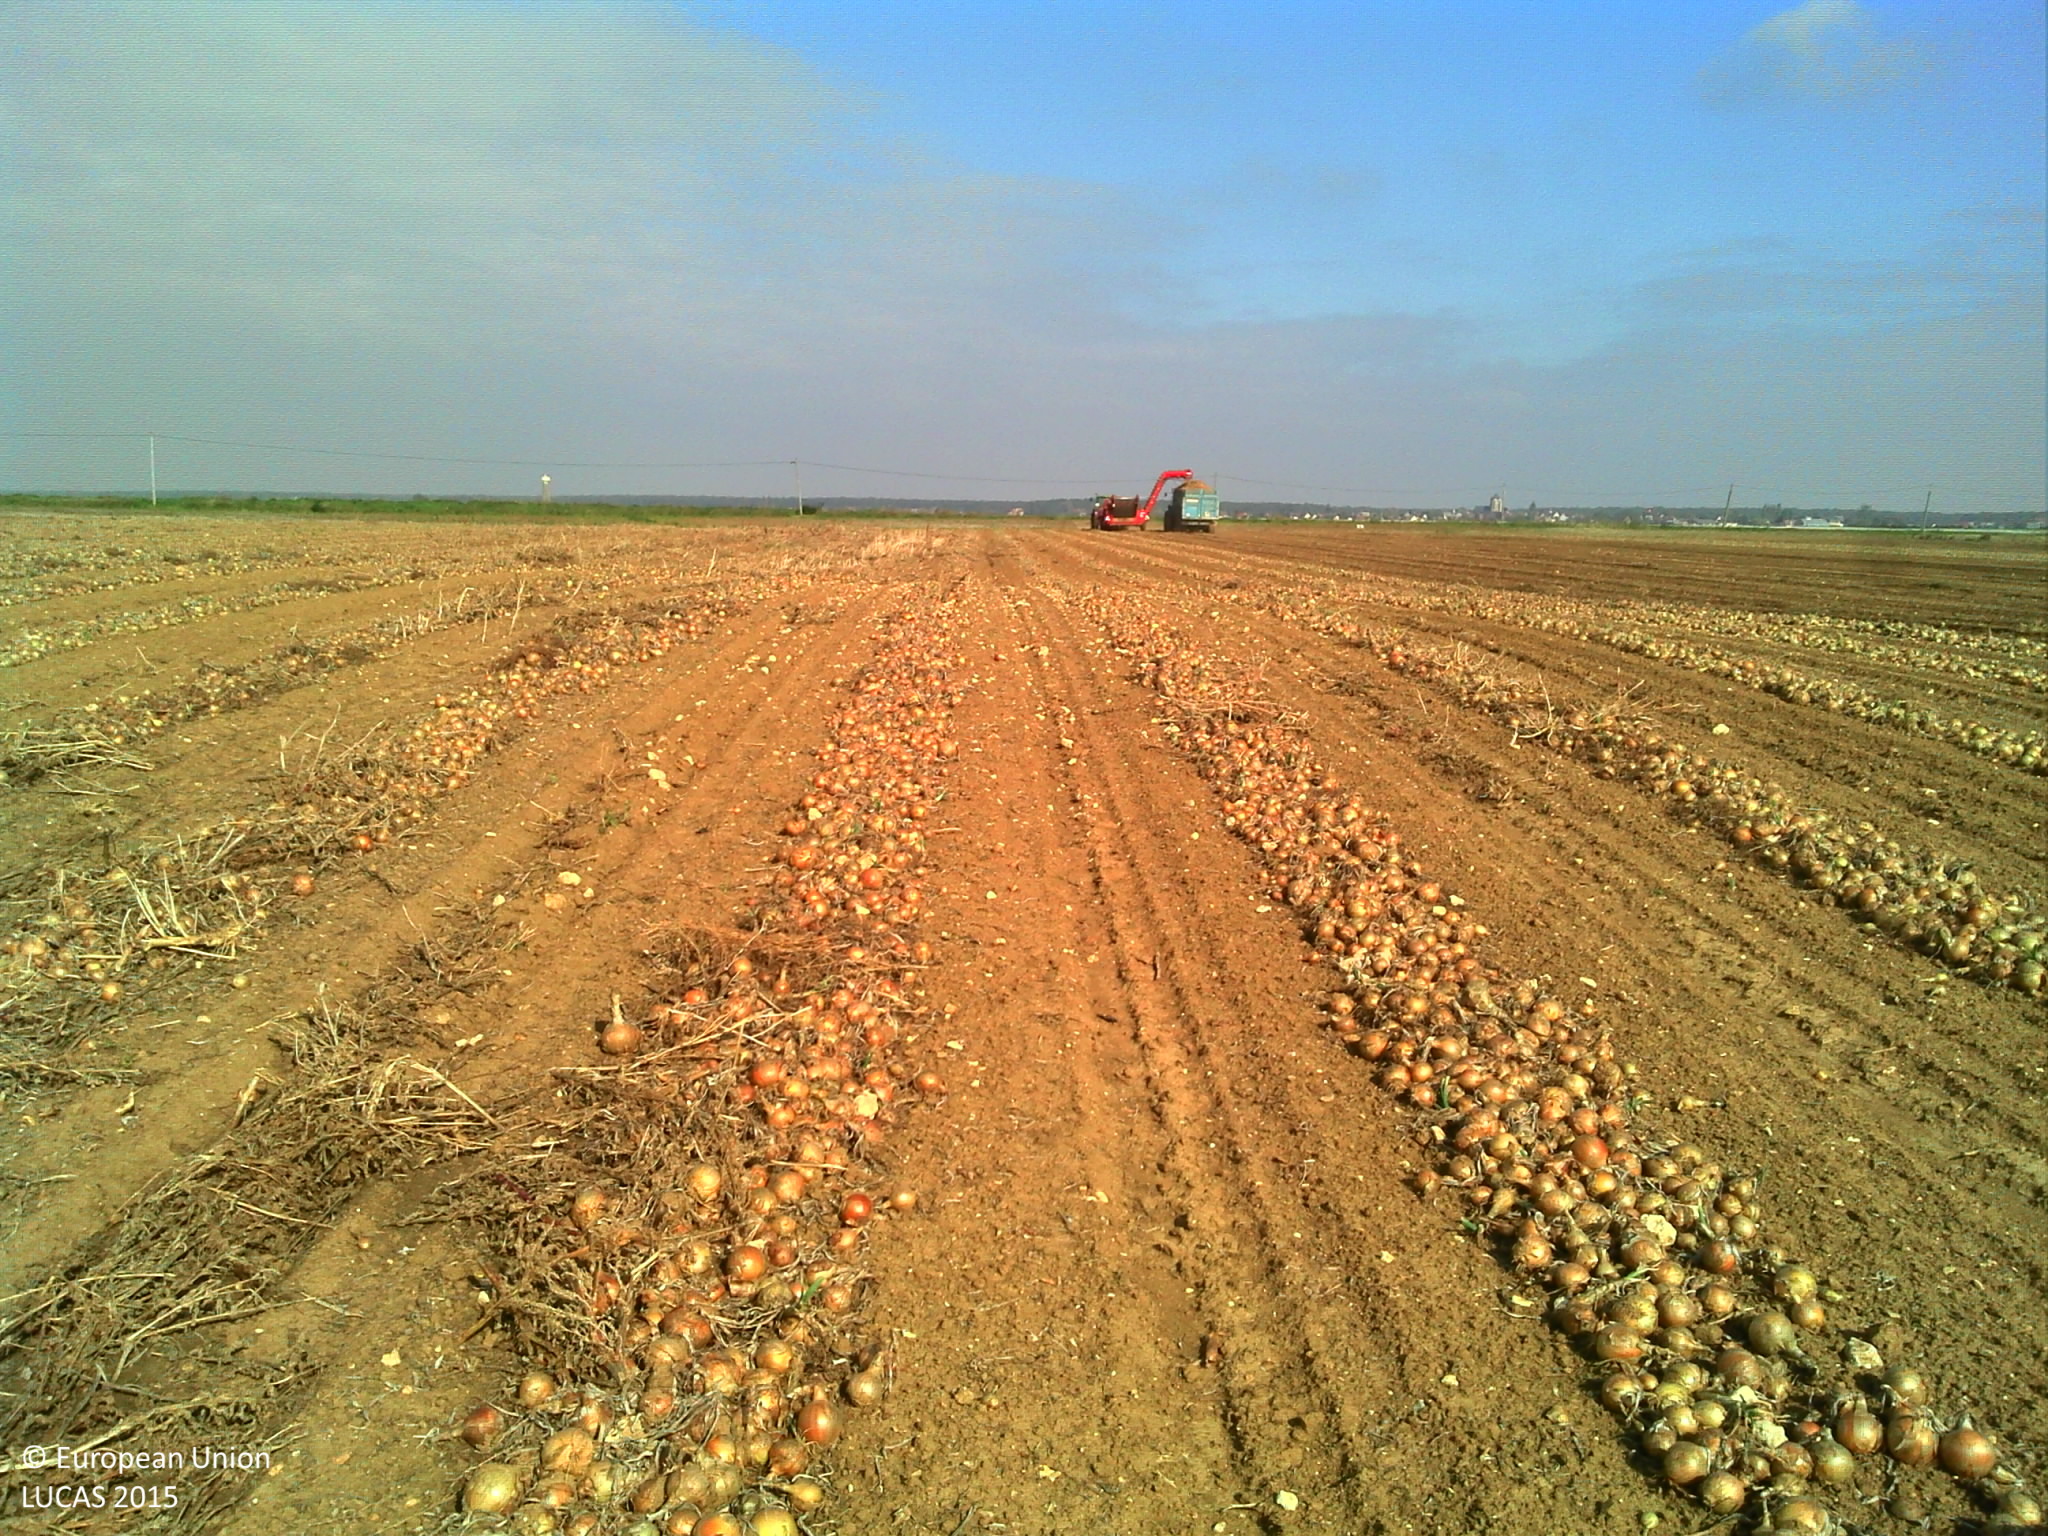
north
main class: Cropland
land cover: Other root crops
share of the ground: 25 - 50 %
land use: Agriculture (excluding fallow land and kitchen gardens)
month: October
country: FR
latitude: 47.8123
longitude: 1.3706
